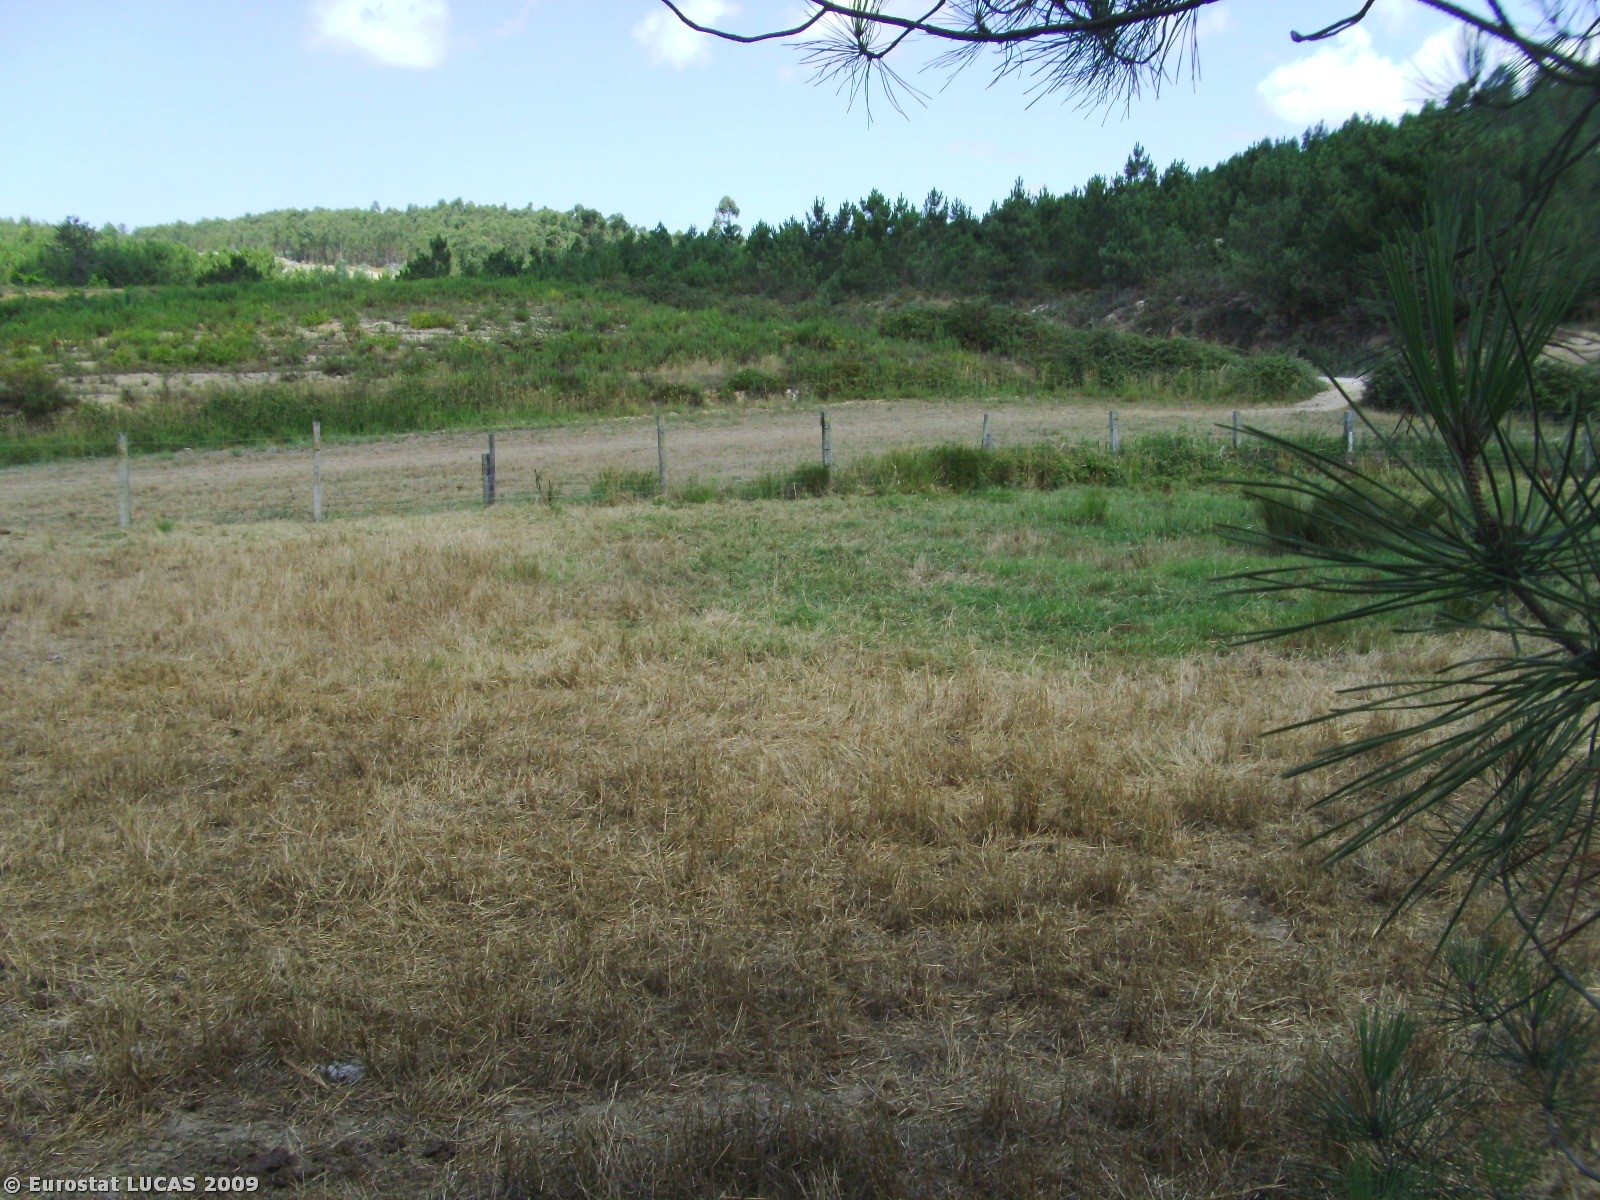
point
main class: Cropland
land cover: Temporary grasslands
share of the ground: > 75 %
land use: Agriculture (excluding fallow land and kitchen gardens)
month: July
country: PT
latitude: 39.1097
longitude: -9.2965
